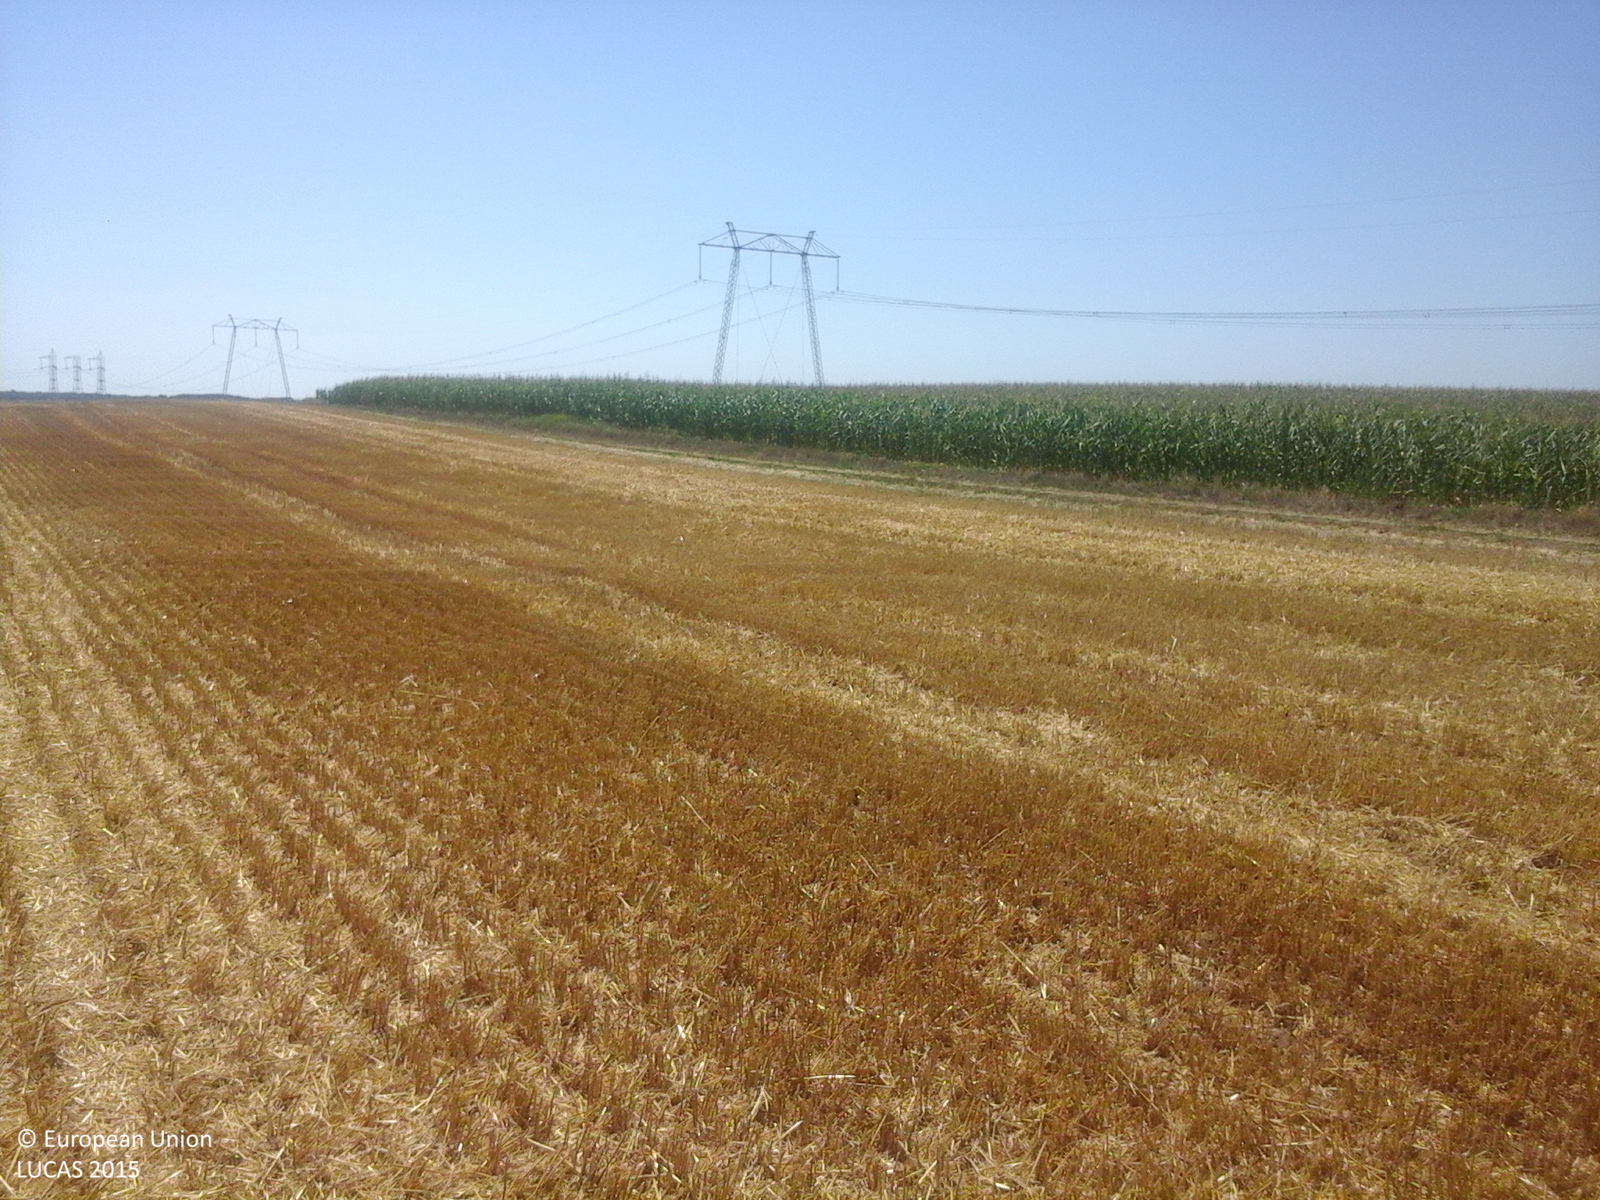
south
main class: Cropland
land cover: Durum wheat
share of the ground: 50 - 75 %
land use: Agriculture (excluding fallow land and kitchen gardens)
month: July
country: RO
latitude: 44.2116
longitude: 26.6236
